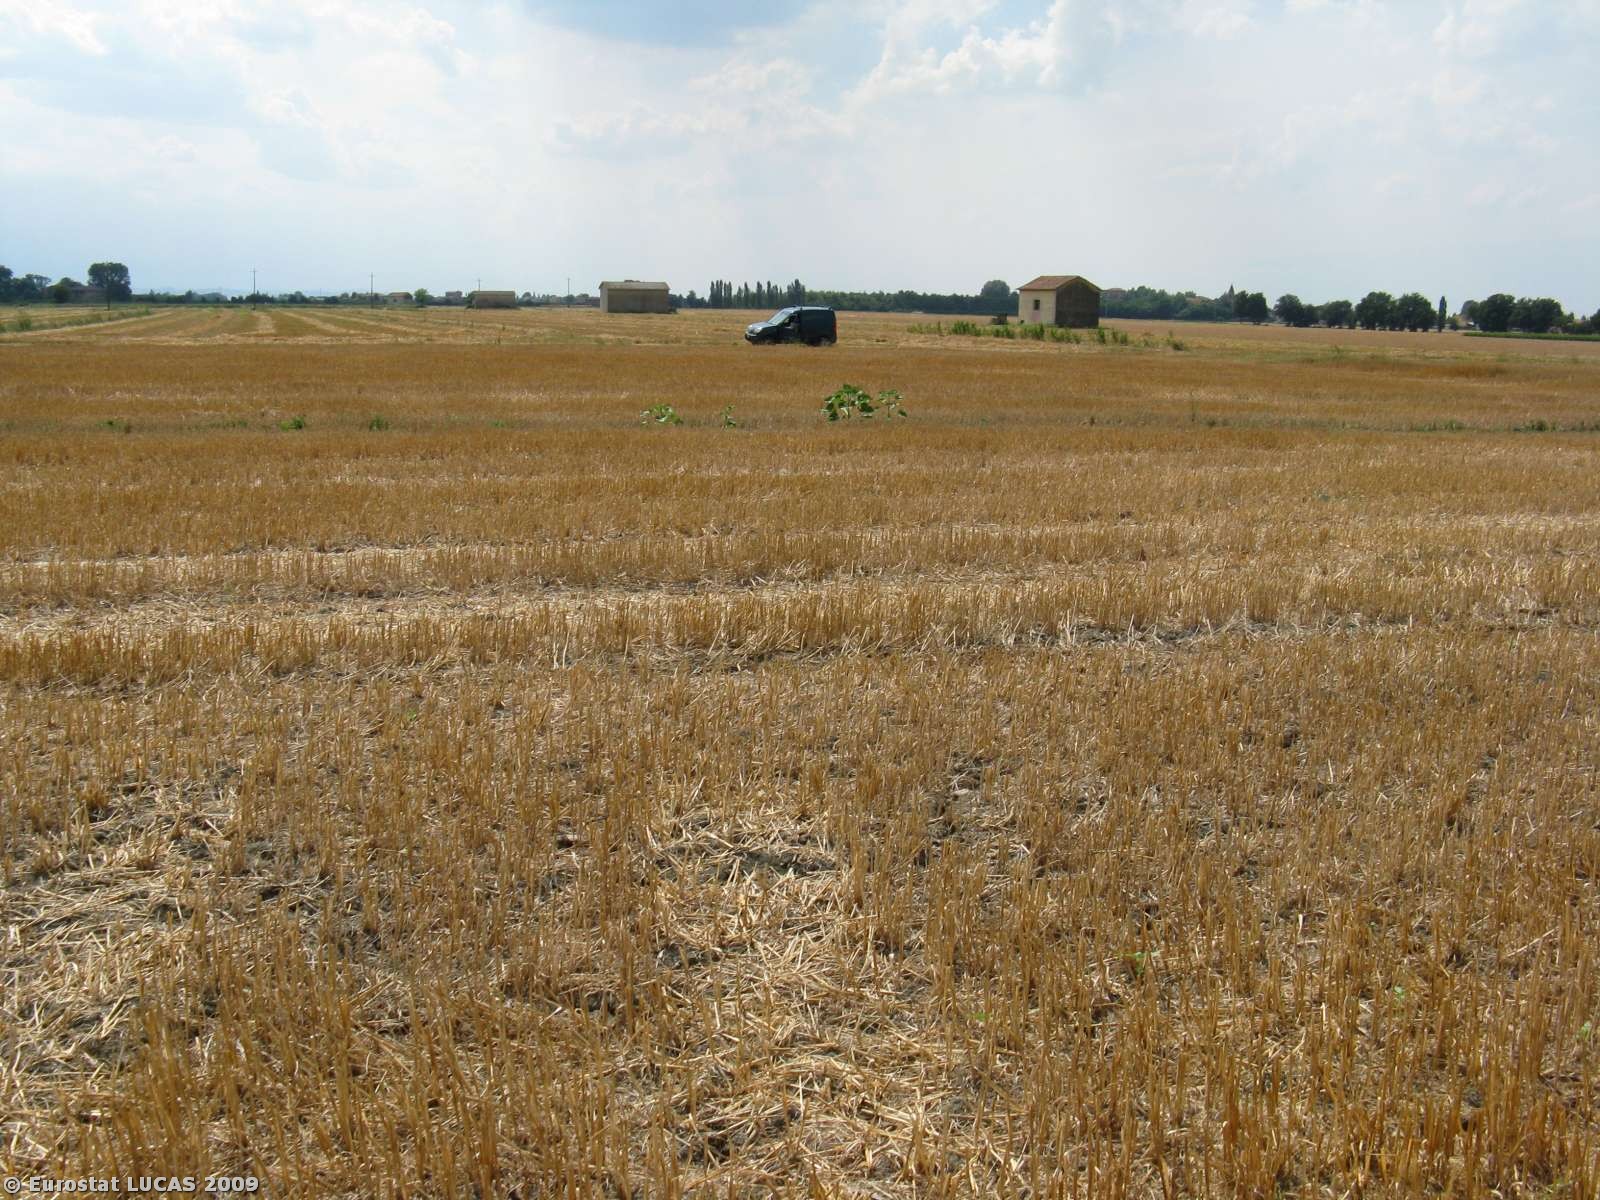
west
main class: Cropland
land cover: Common wheat
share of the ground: < 10 %
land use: Agriculture (excluding fallow land and kitchen gardens)
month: July
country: IT
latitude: 44.5540
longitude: 11.6456
